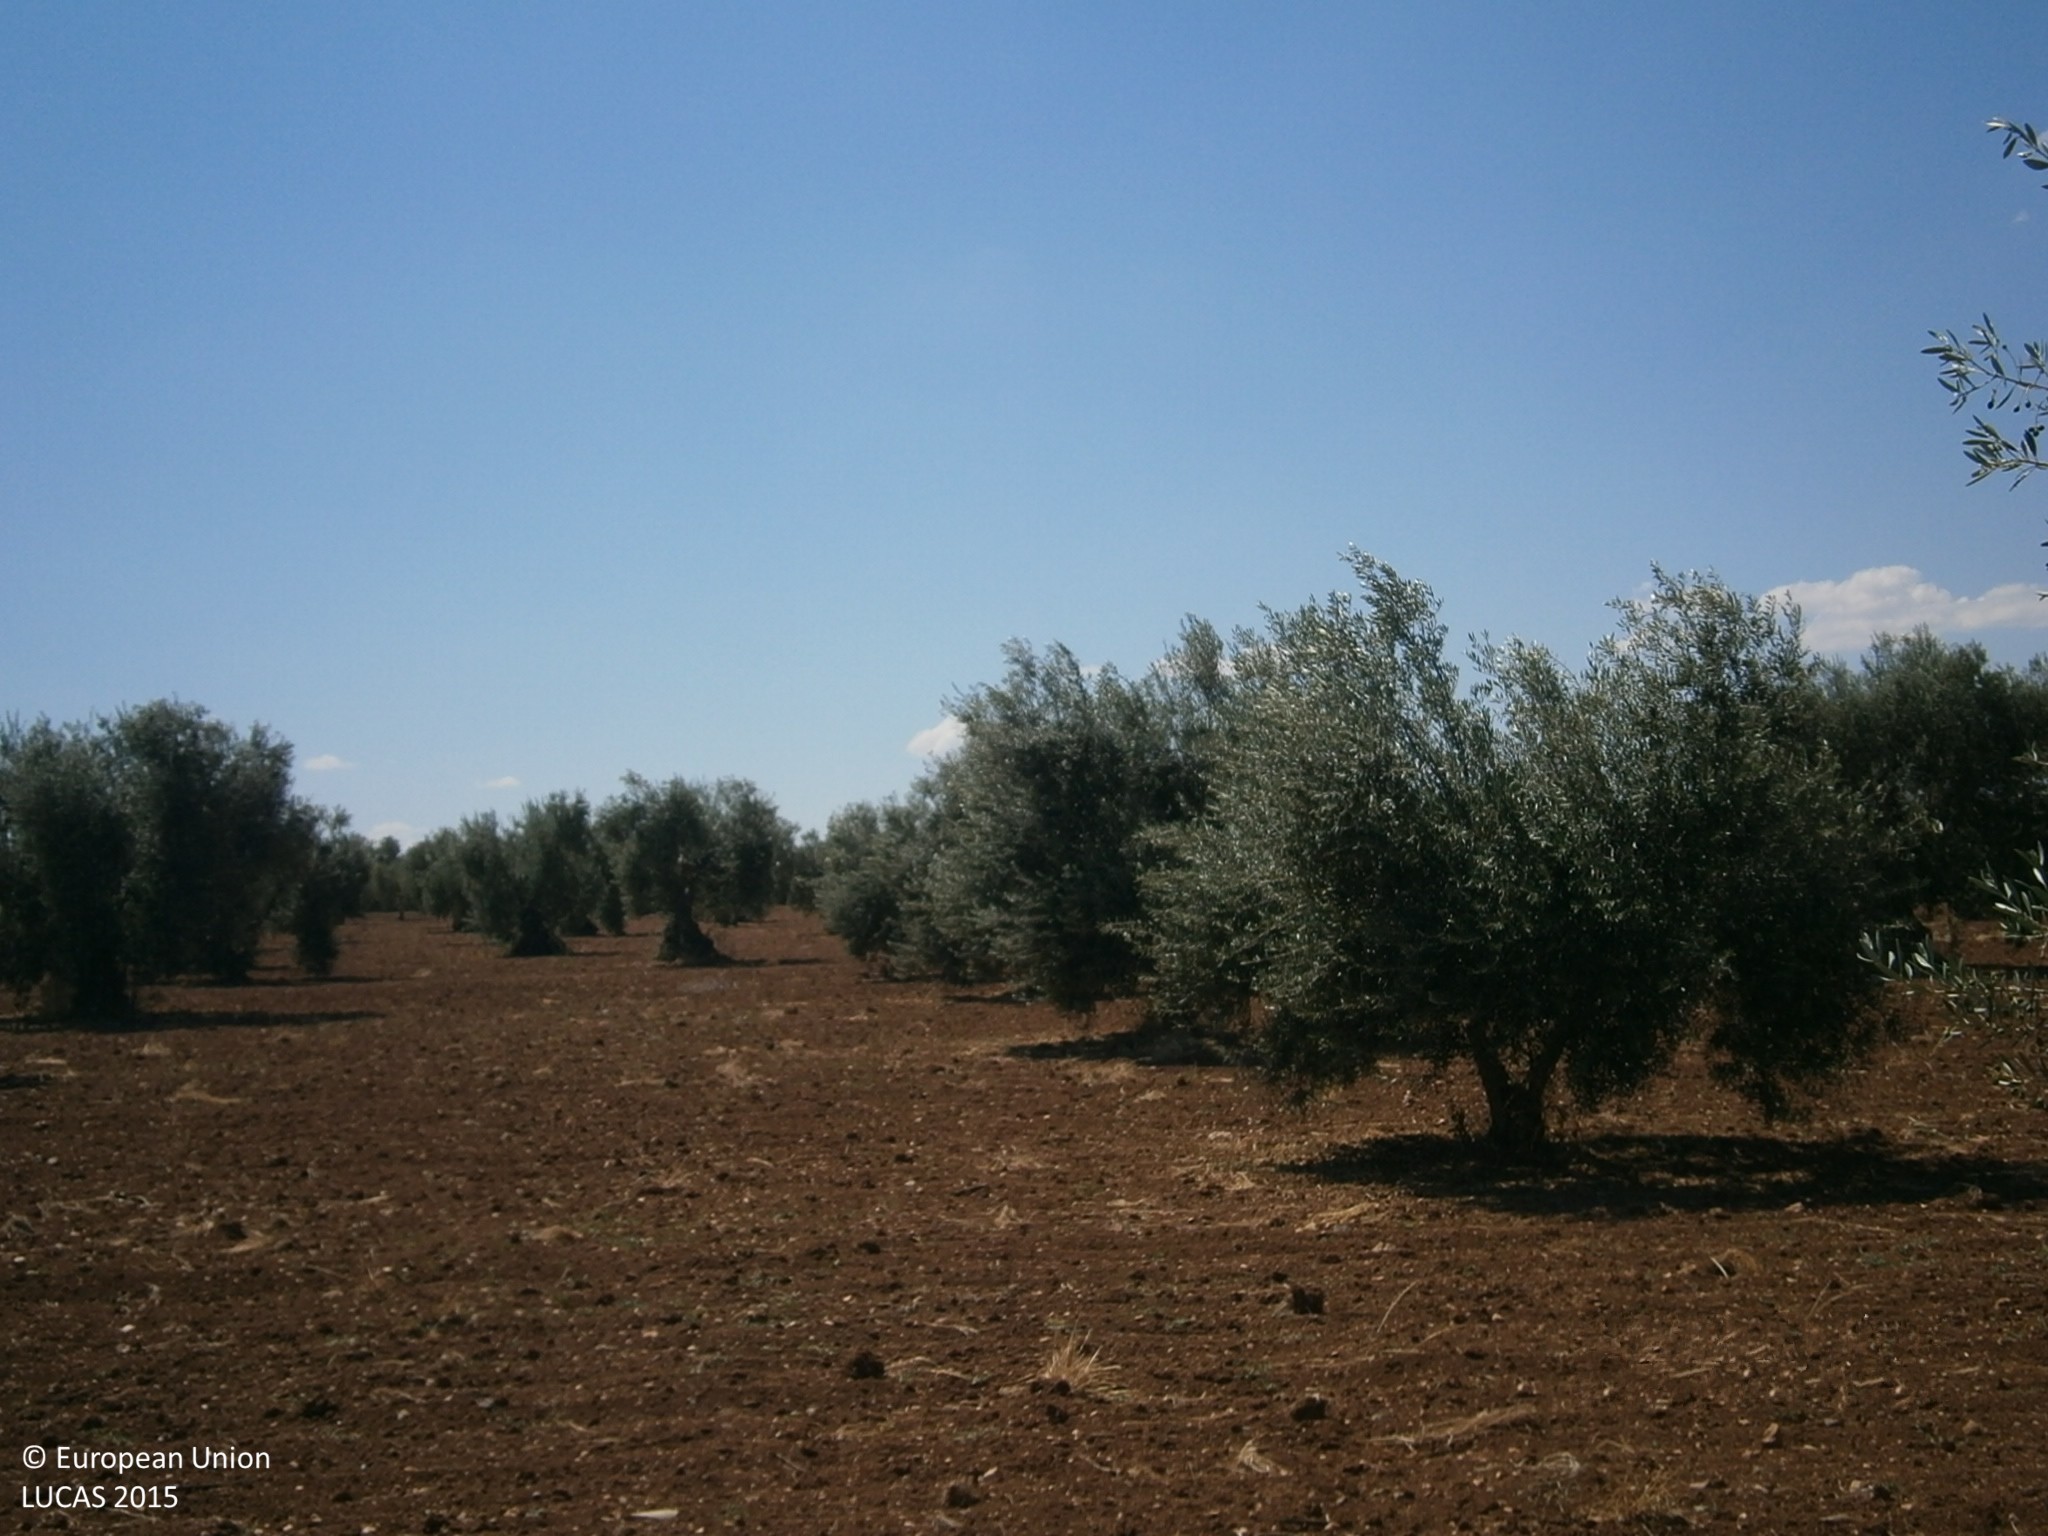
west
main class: Cropland
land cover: Olive groves
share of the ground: 25 - 50 %
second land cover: Other bare soil
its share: > 75 %
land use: Agriculture (excluding fallow land and kitchen gardens)
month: June
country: ES
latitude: 38.5977
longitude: -6.4152
